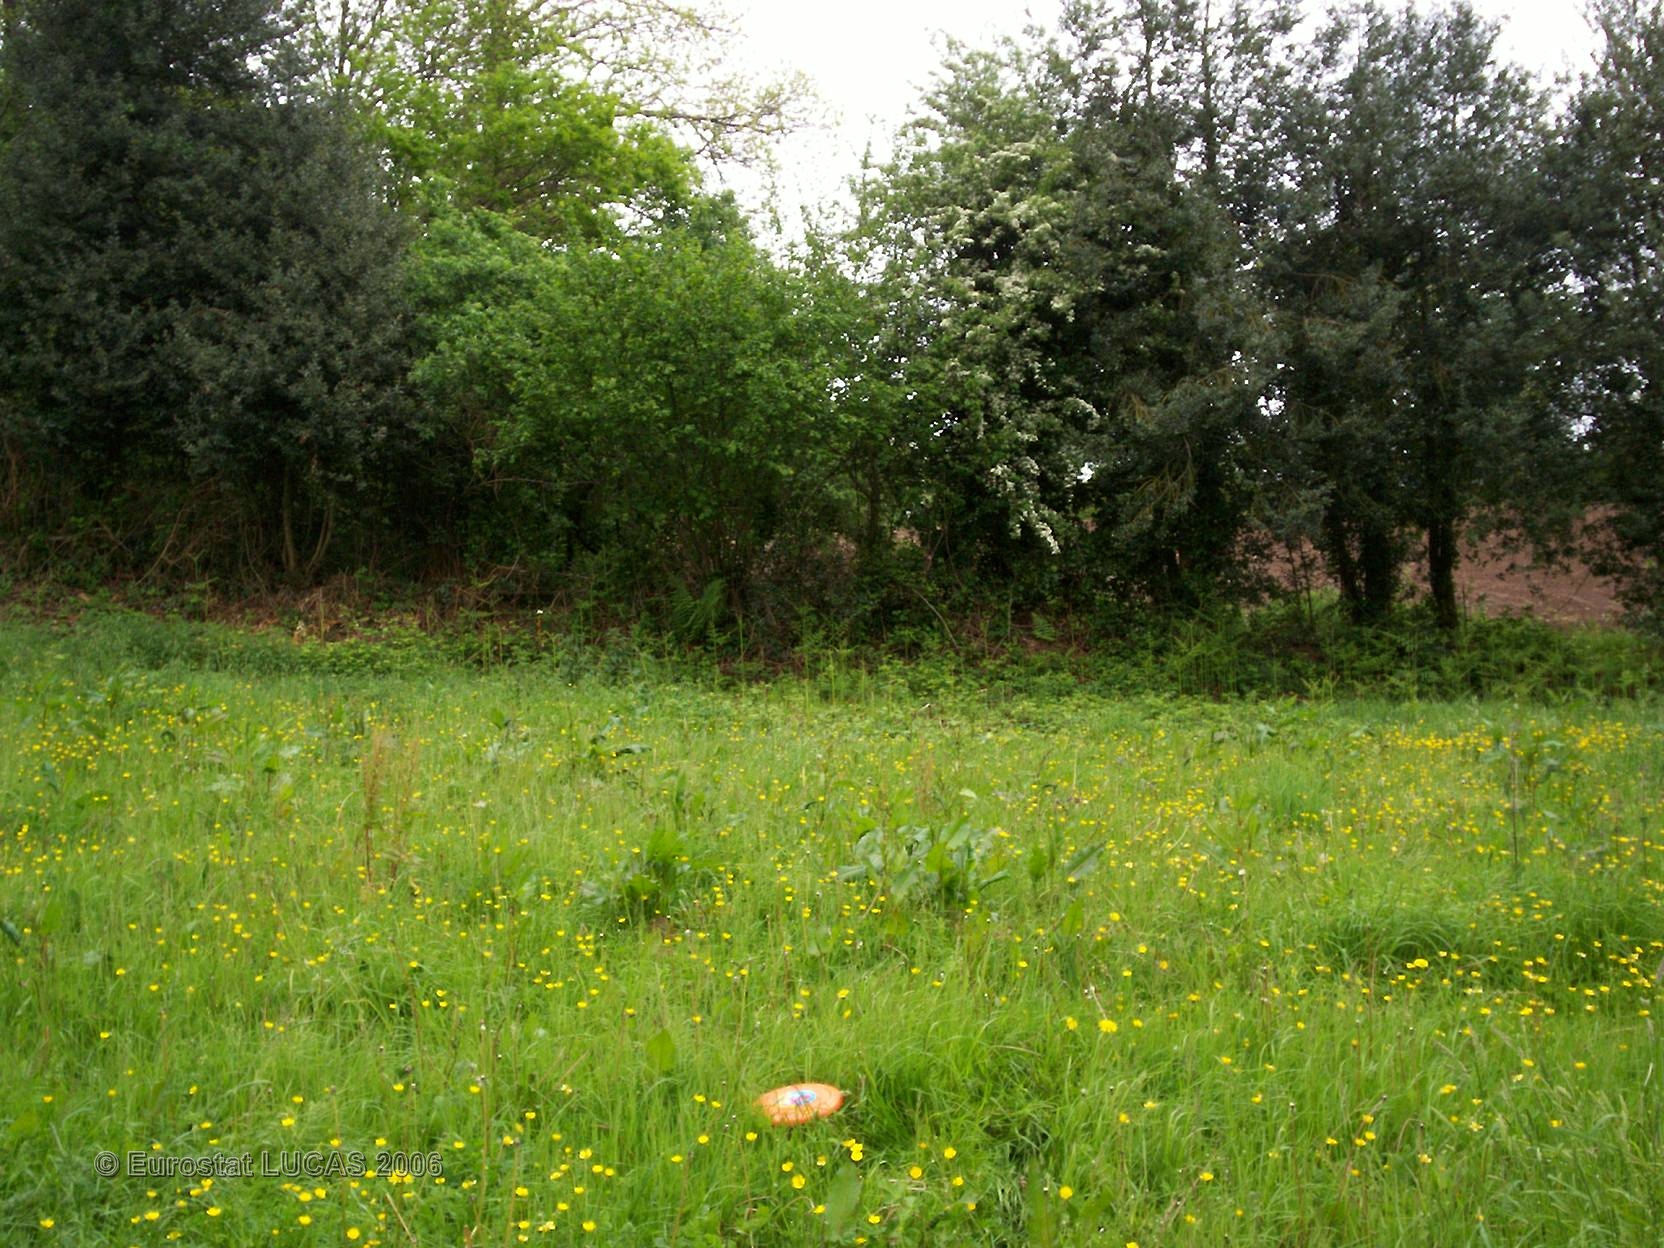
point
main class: Grassland
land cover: Grassland without tree/shrub cover
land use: Agriculture (excluding fallow land and kitchen gardens)
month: May
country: FR
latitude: 48.0686
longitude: -3.8940
